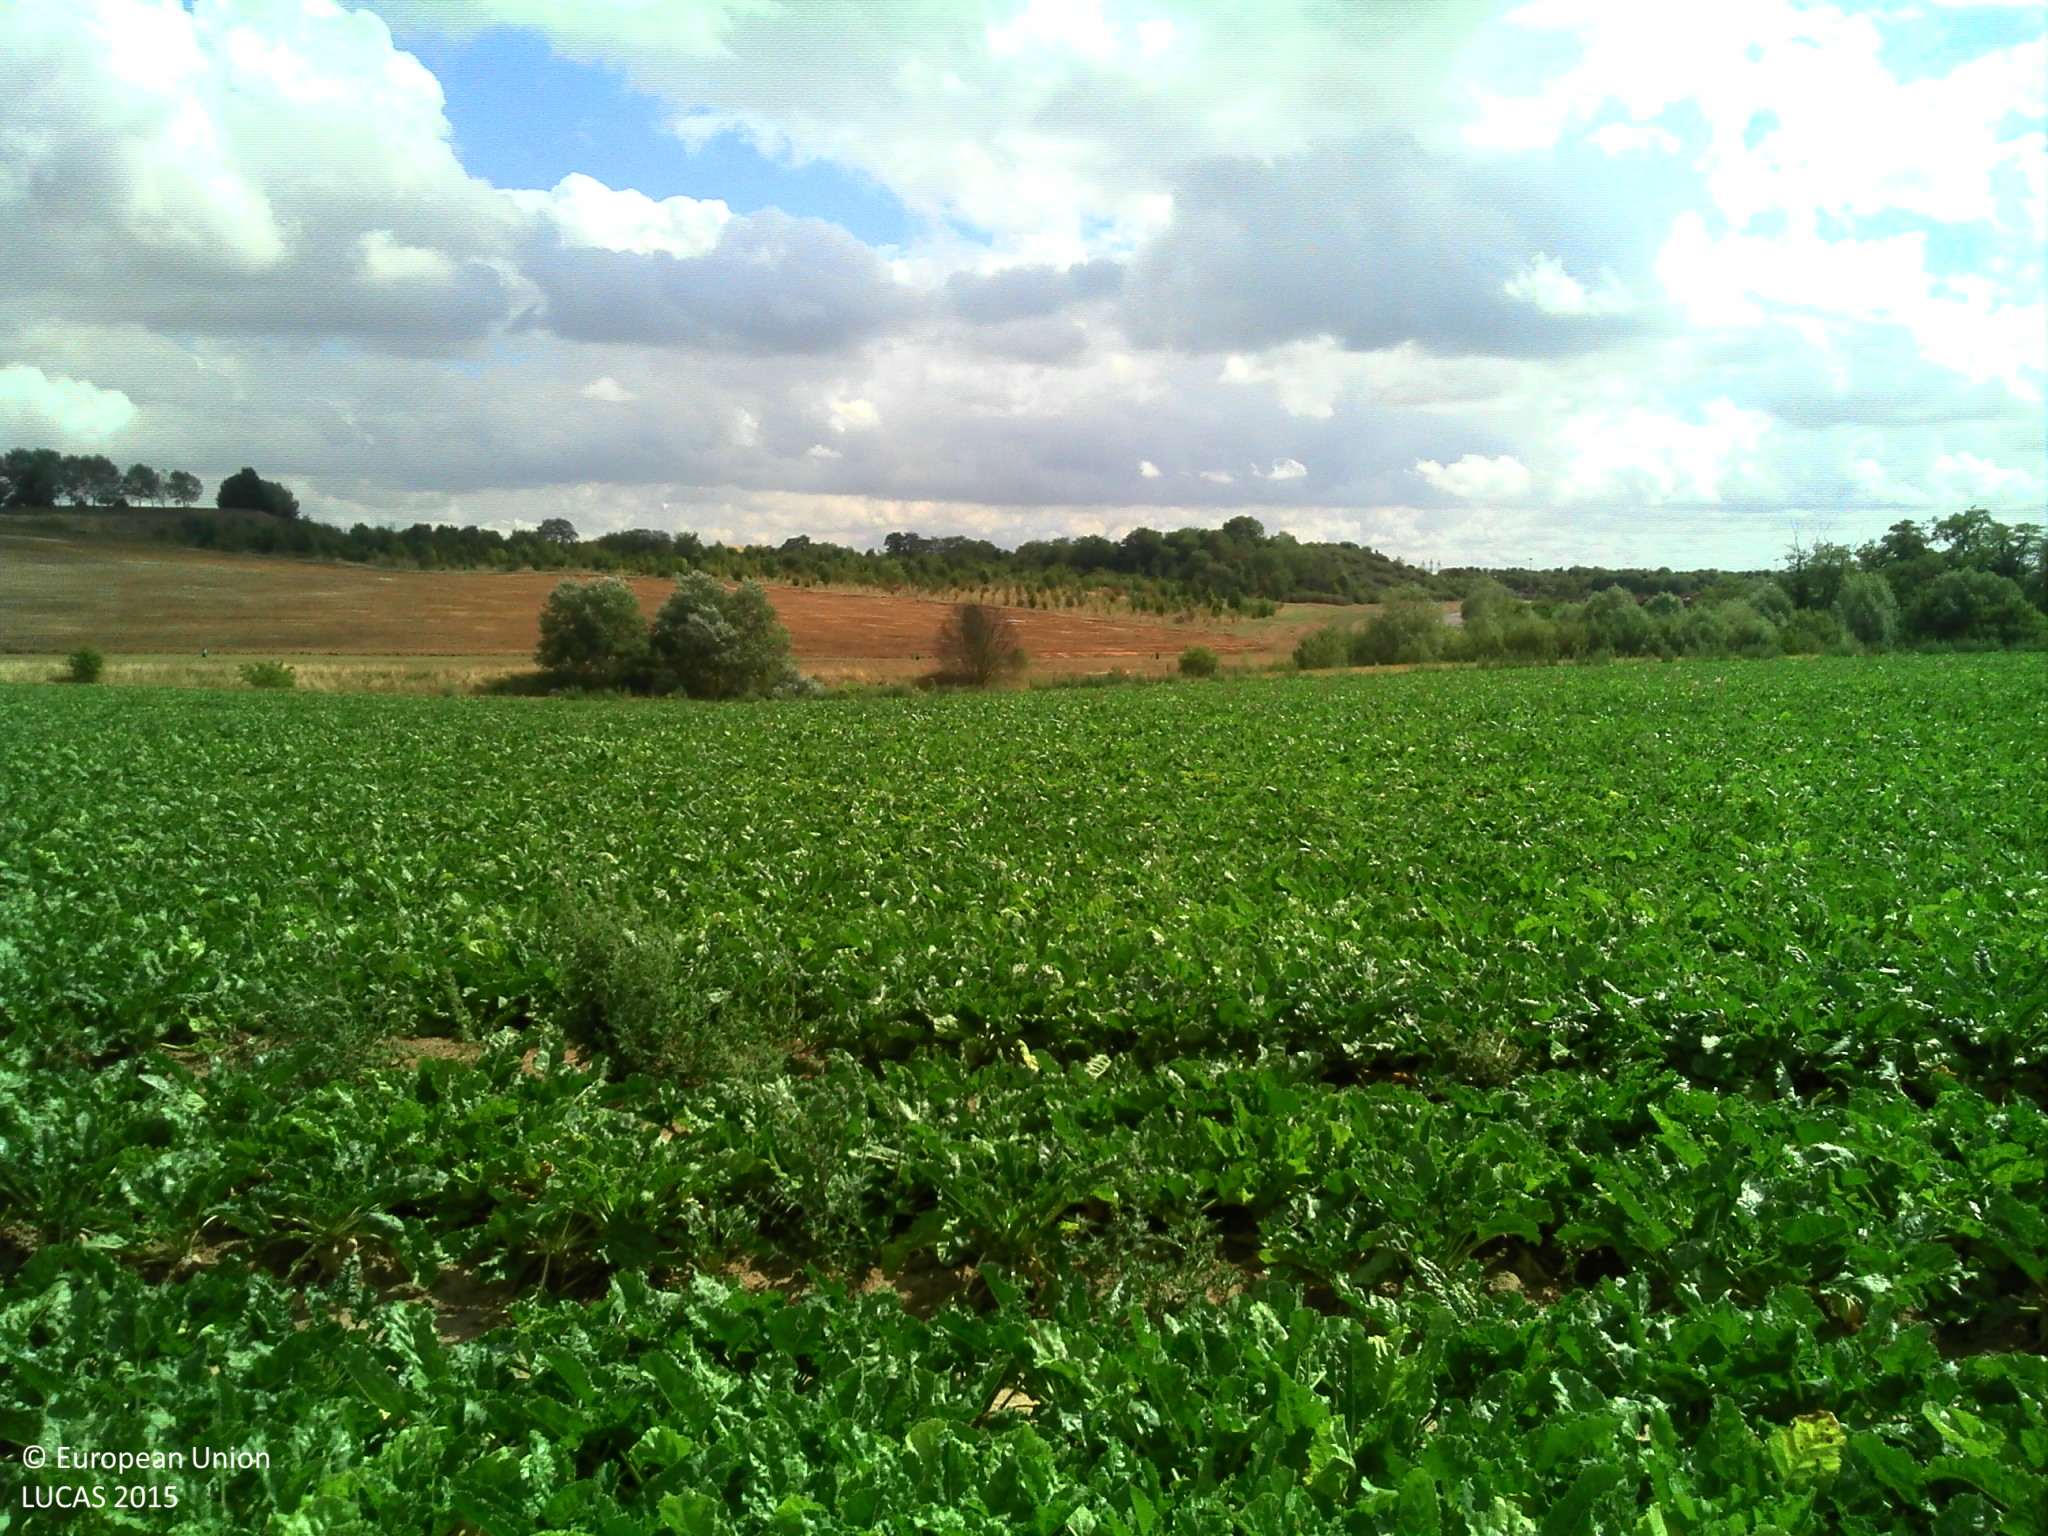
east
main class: Cropland
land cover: Sugar beet
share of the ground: > 75 %
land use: Agriculture (excluding fallow land and kitchen gardens)
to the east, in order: Sugar beet; Grassland without tree/shrub cover; Fences; Grassland with sparse tree/shrub cover; Fences; Tracks
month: August
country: FR
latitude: 49.0270
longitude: 2.3976
